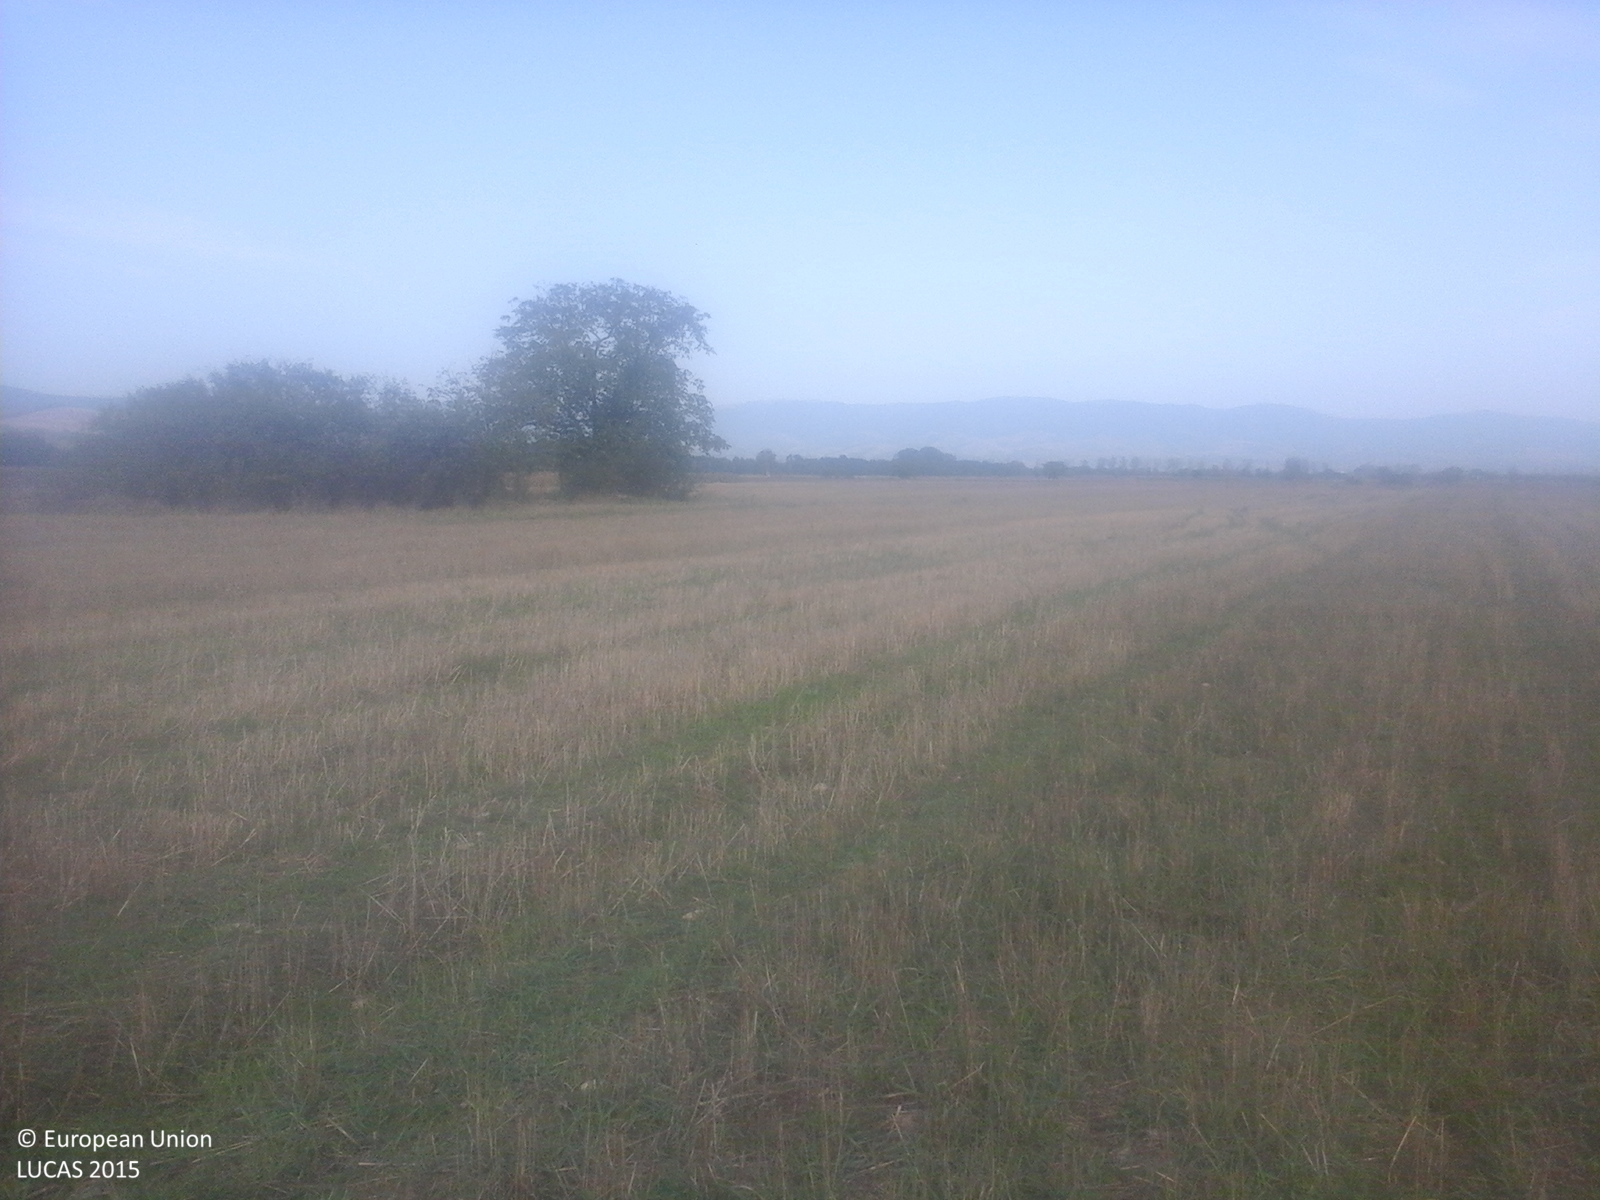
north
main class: Cropland
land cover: Common wheat
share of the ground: 50 - 75 %
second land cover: Spontaneously vegetated surfaces
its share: 50 - 75 %
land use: Agriculture (excluding fallow land and kitchen gardens)
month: September
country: RO
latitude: 45.5189
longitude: 22.8396
